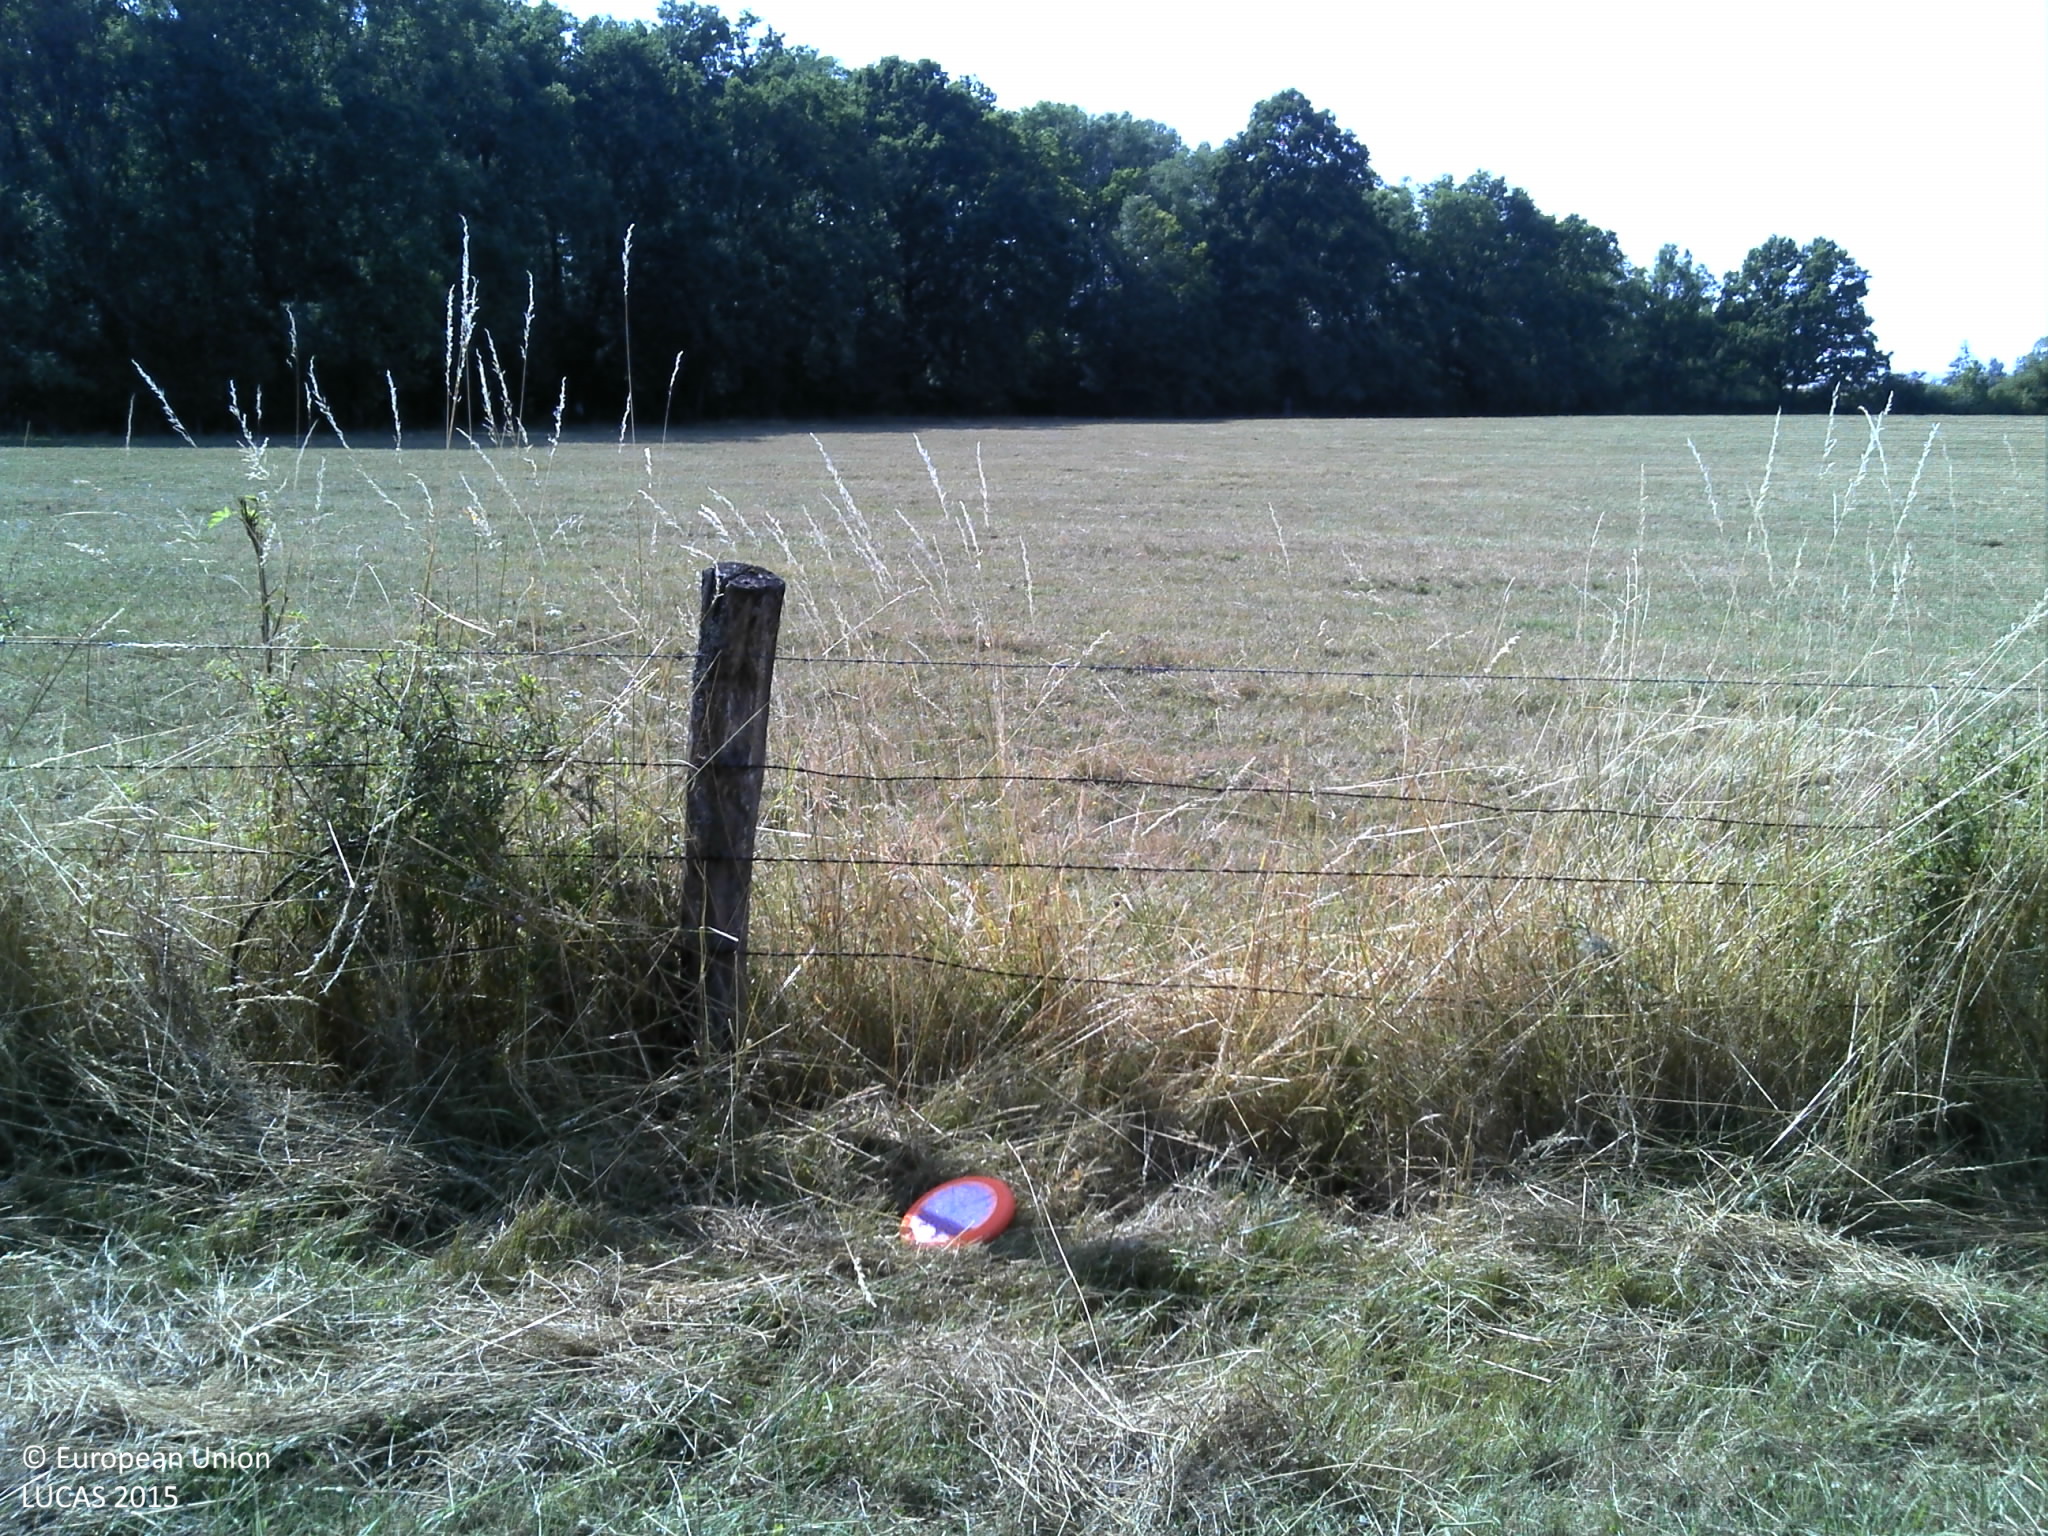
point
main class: Grassland
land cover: Grassland without tree/shrub cover
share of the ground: > 75 %
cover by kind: herbaceous plants 100 %
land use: Agriculture (excluding fallow land and kitchen gardens)
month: July
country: FR
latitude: 48.8583
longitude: 4.8045
